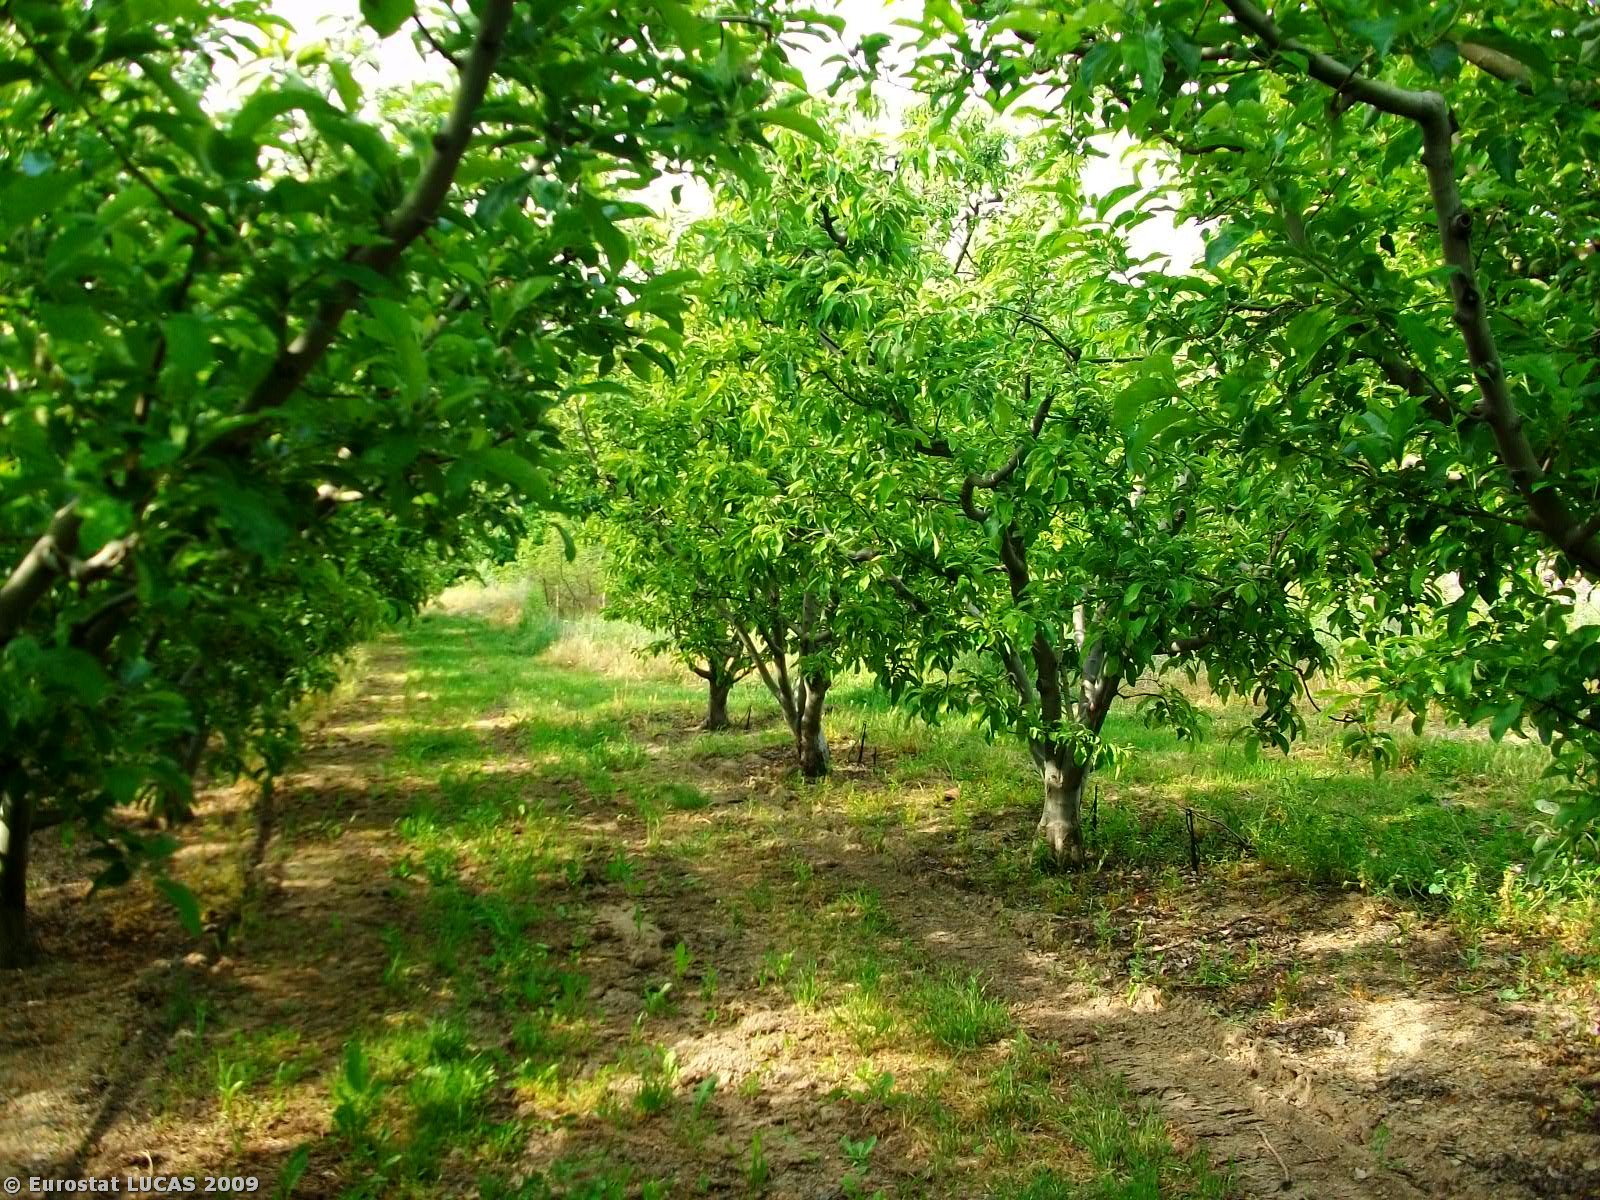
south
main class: Cropland
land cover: Apple fruit
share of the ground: > 75 %
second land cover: Grassland with sparse tree/shrub cover
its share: 50 - 75 %
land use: Agriculture (excluding fallow land and kitchen gardens)
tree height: > 5 m
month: May
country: GR
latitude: 40.7335
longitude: 21.8498
